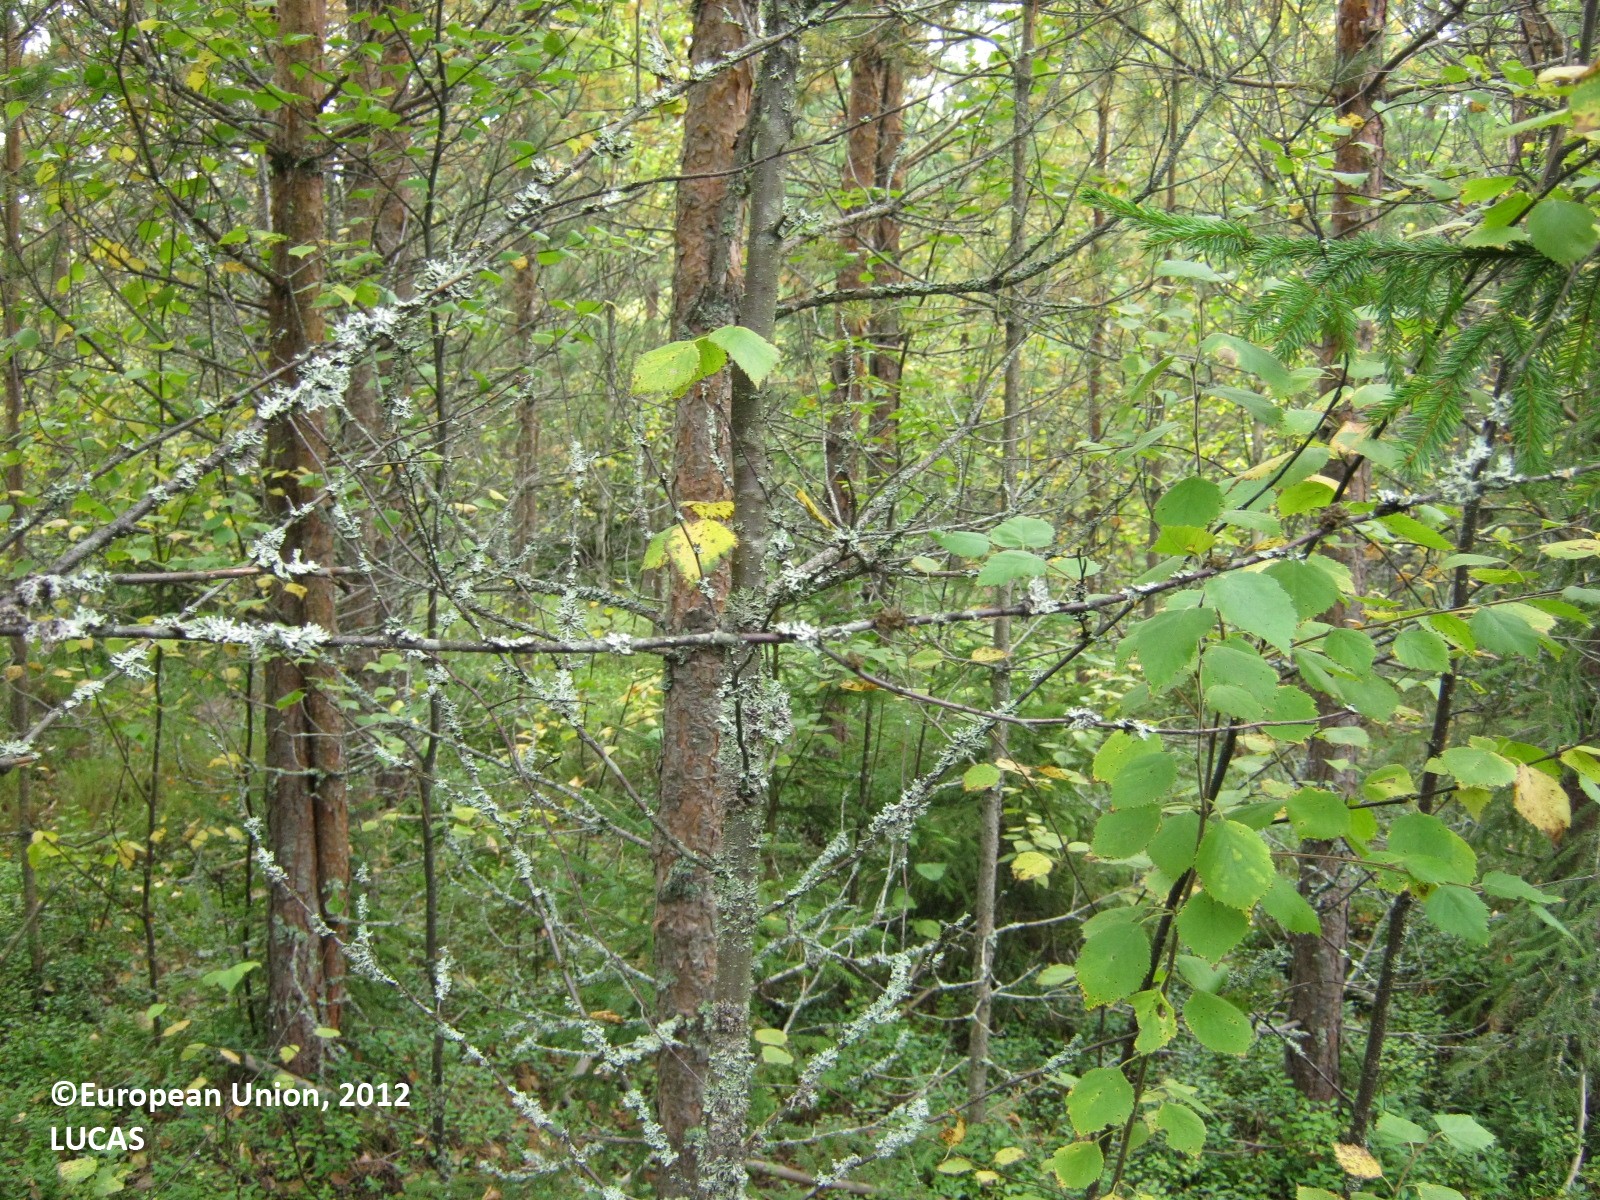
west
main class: Woodland
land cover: Pine dominated mixed woodland
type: boreal forest
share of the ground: > 75 %
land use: Forestry
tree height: > 5 m
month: September
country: FI
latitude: 60.5810
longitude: 27.5818
